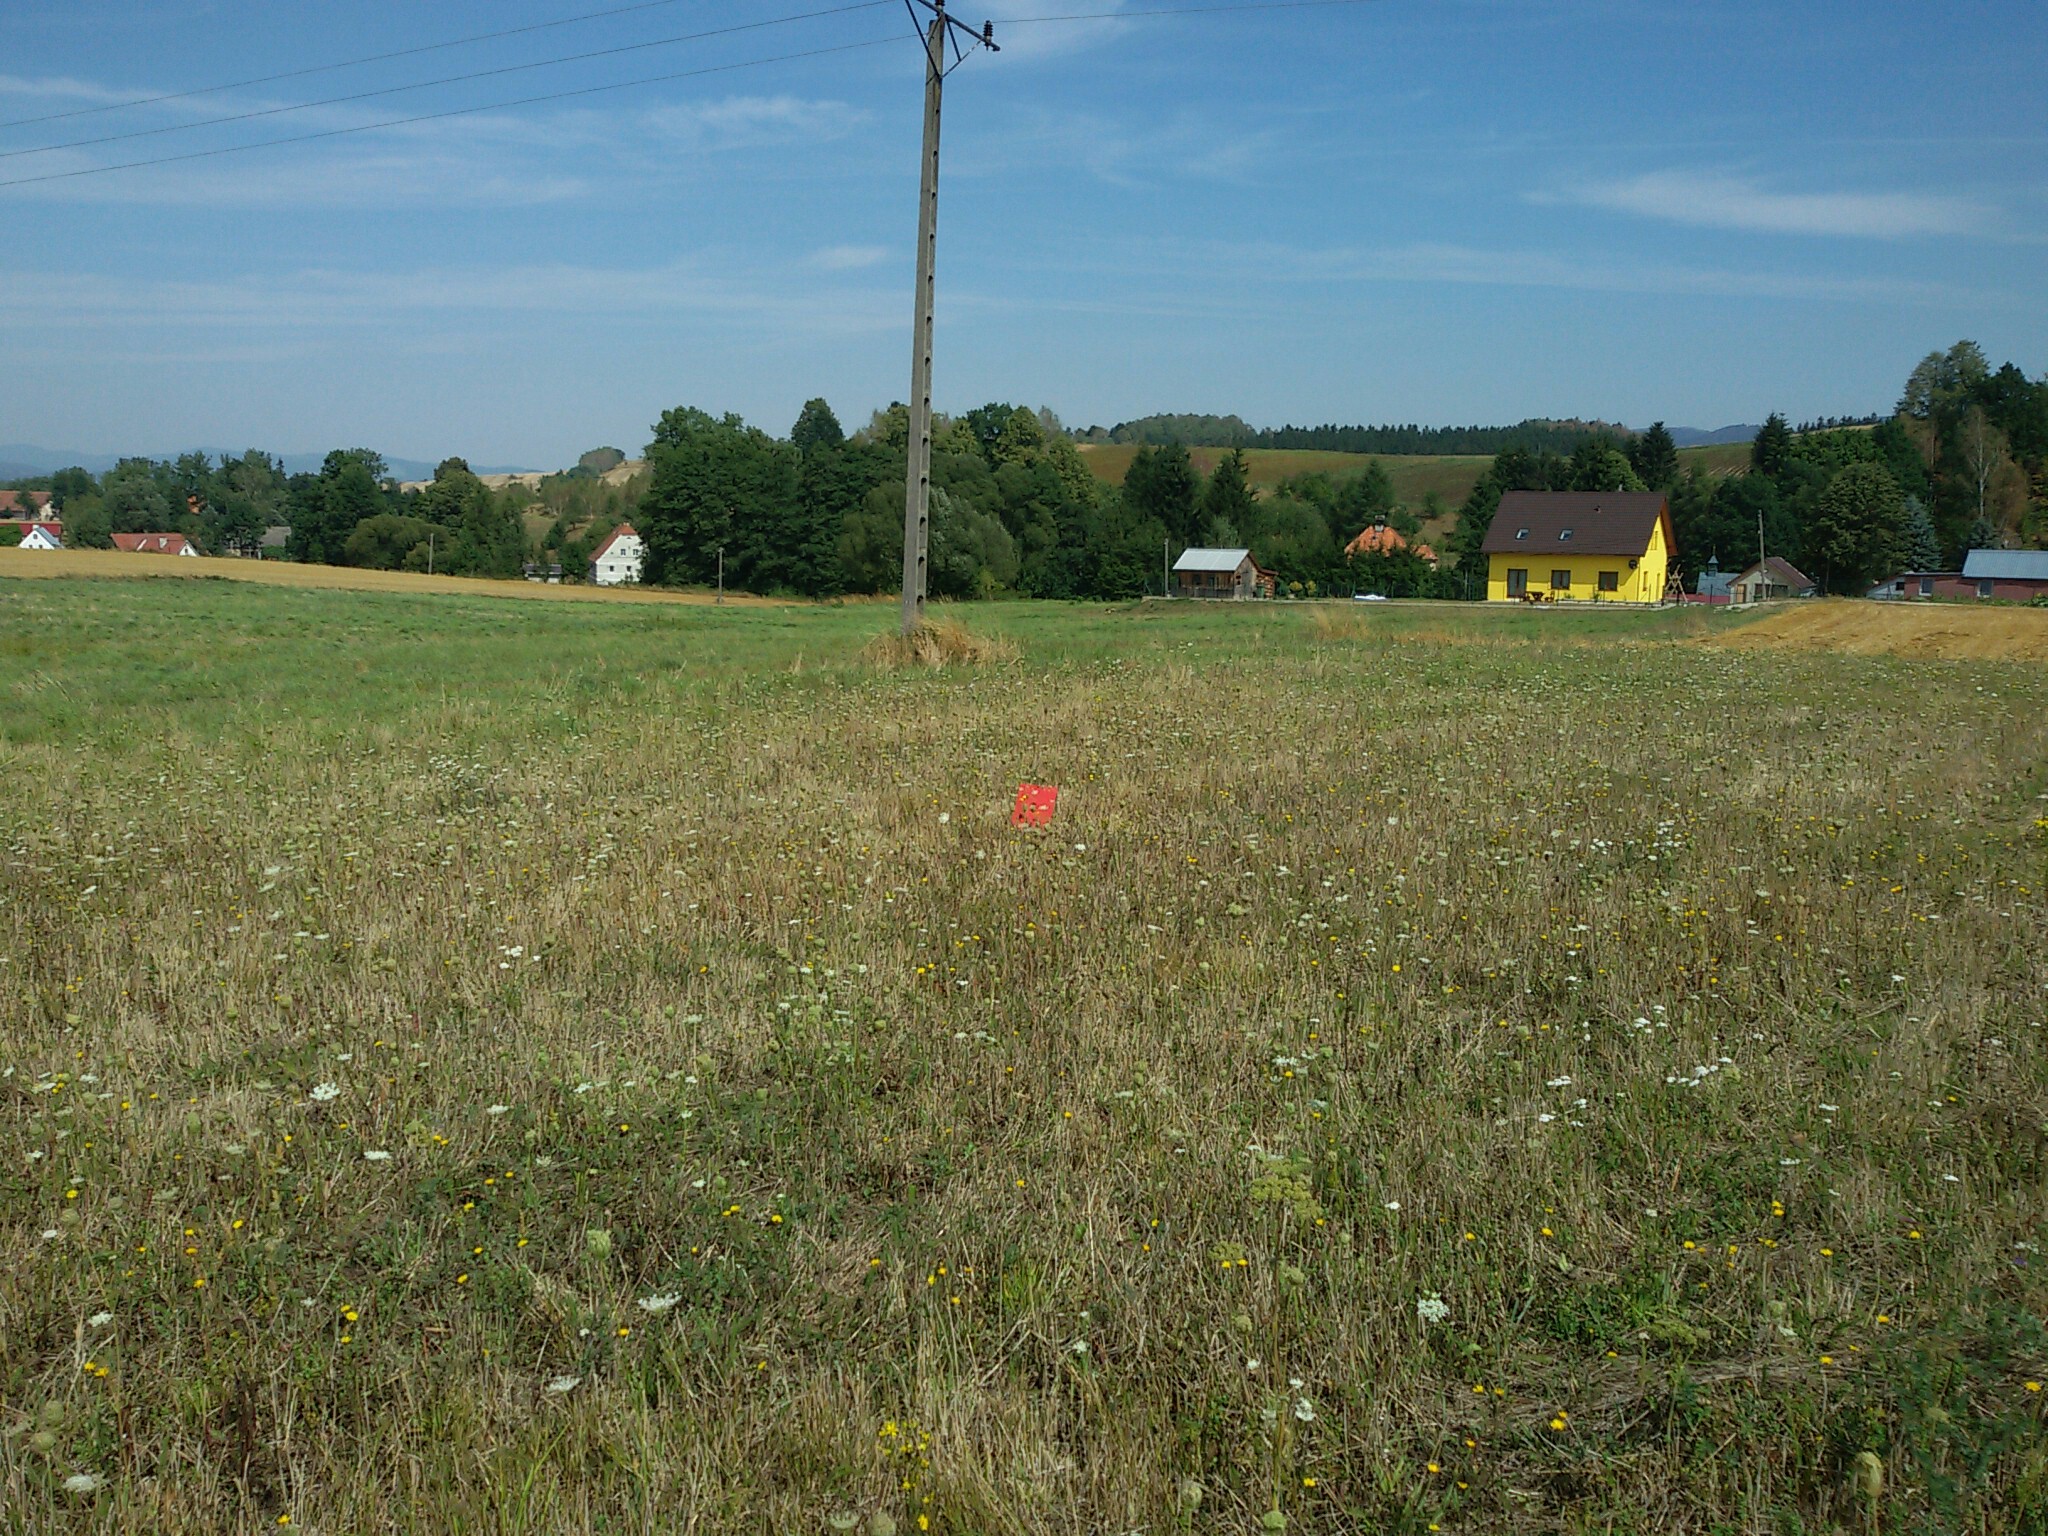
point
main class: Grassland
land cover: Grassland without tree/shrub cover
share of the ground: > 75 %
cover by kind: herbaceous plants 100 %
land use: Agriculture (excluding fallow land and kitchen gardens)
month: August
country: PL
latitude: 50.3847
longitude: 16.6889
